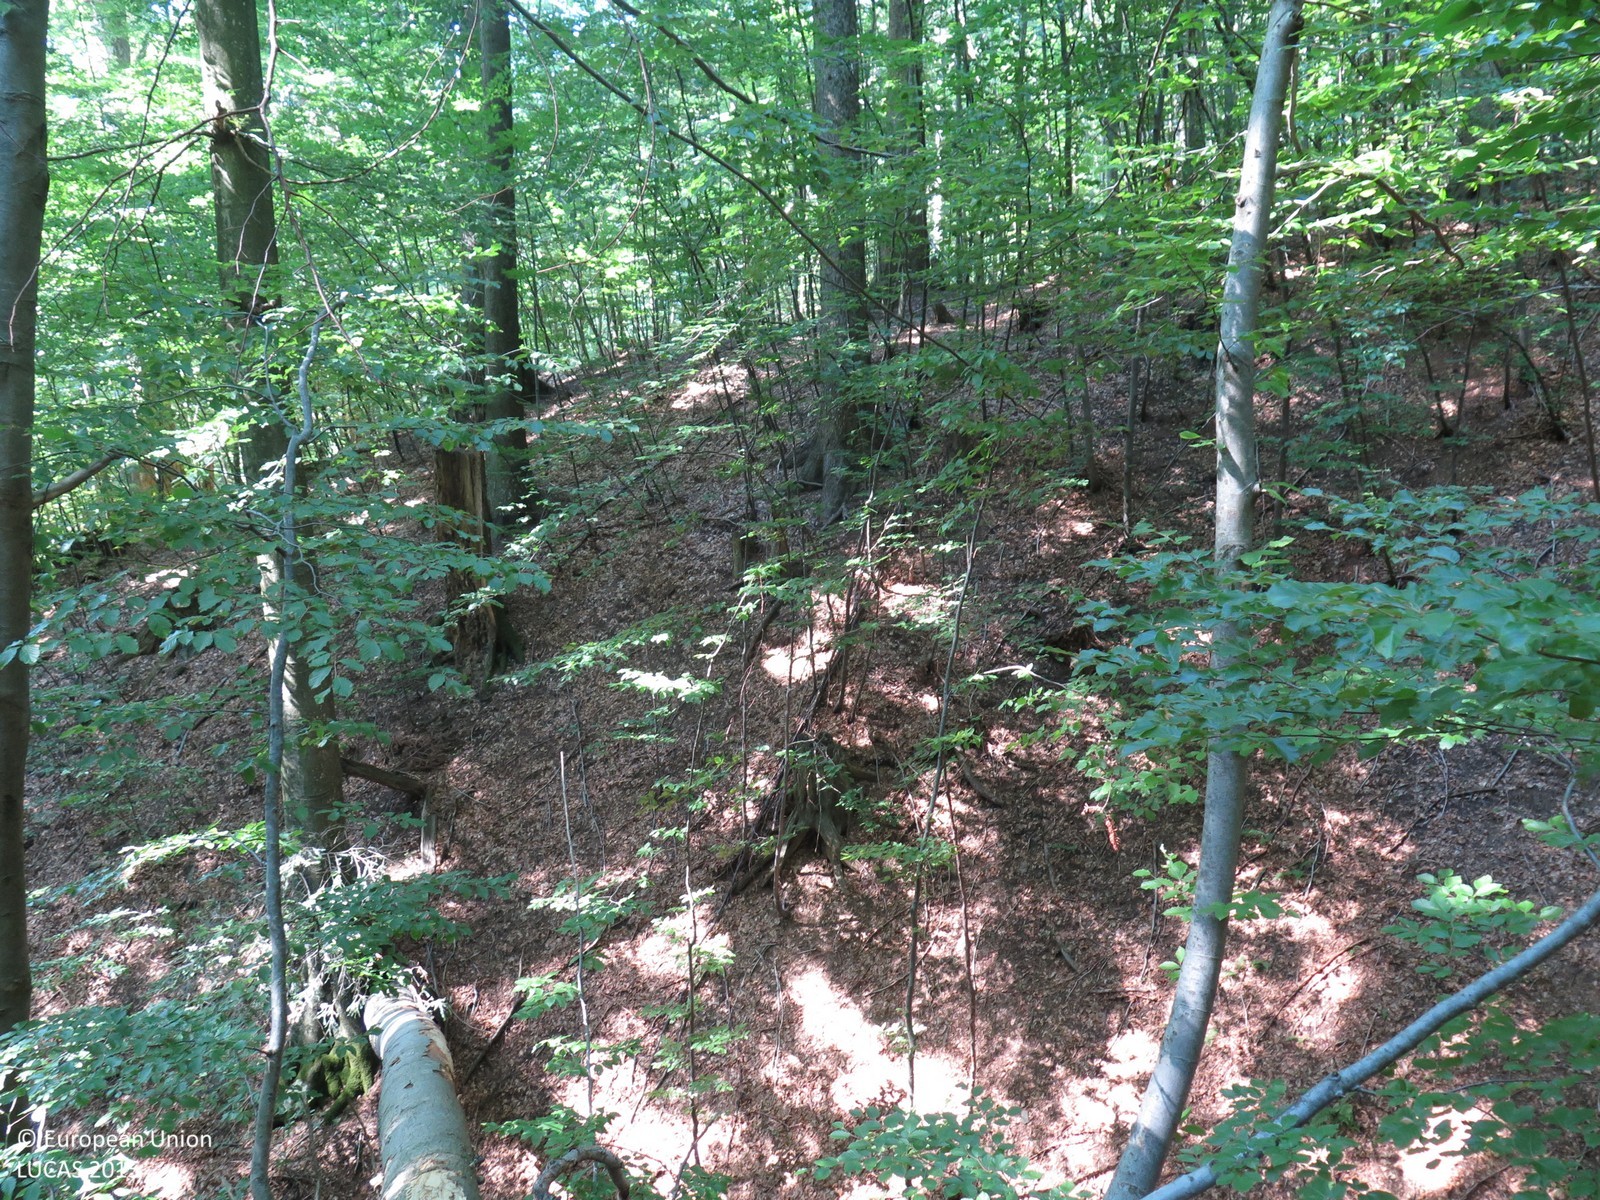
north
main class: Woodland
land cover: Broadleaved woodland
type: beech forest
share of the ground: > 75 %
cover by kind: broadleaved forest trees 100 %
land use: Forestry
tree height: > 5 m
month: August
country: HR
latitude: 45.3477
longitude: 14.6537
